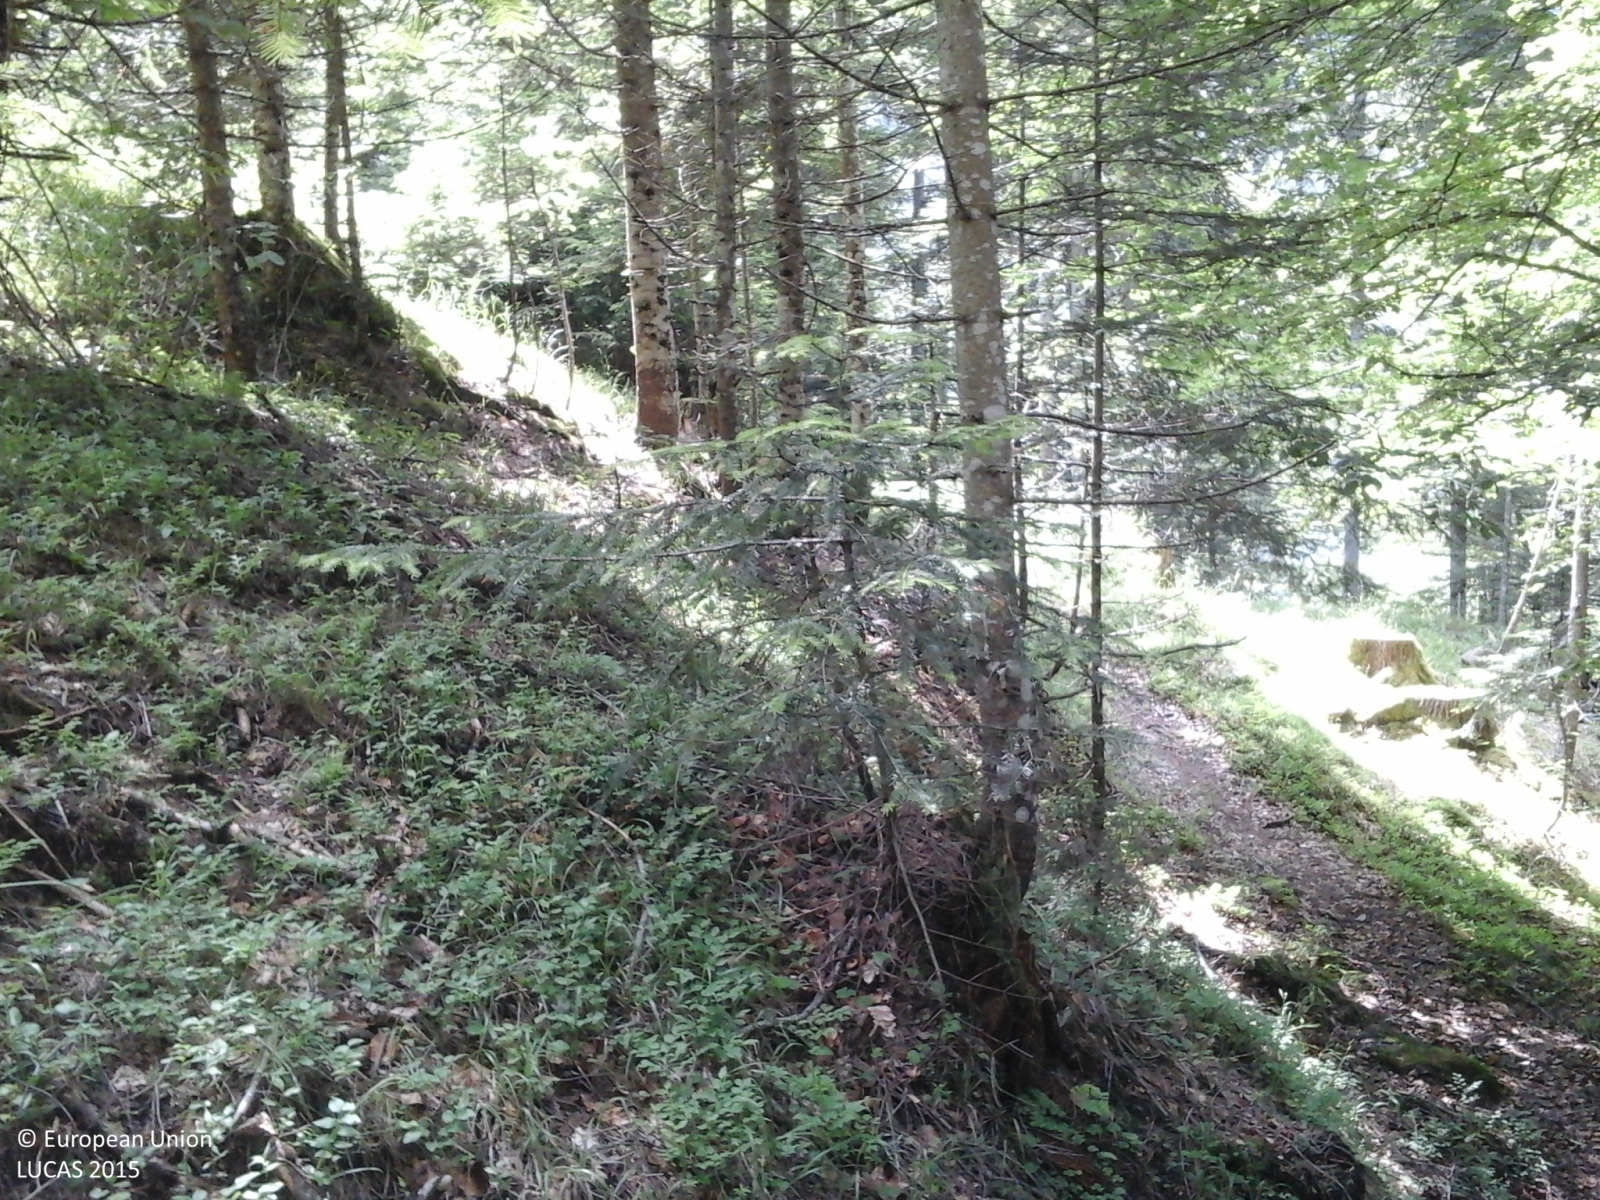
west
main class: Woodland
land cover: Spruce dominated coniferous woodland
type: alpine coniferous forest
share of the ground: > 75 %
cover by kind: coniferous forest trees 100 %
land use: Forestry
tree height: > 5 m
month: June
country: IT
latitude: 46.1067
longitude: 11.4857
